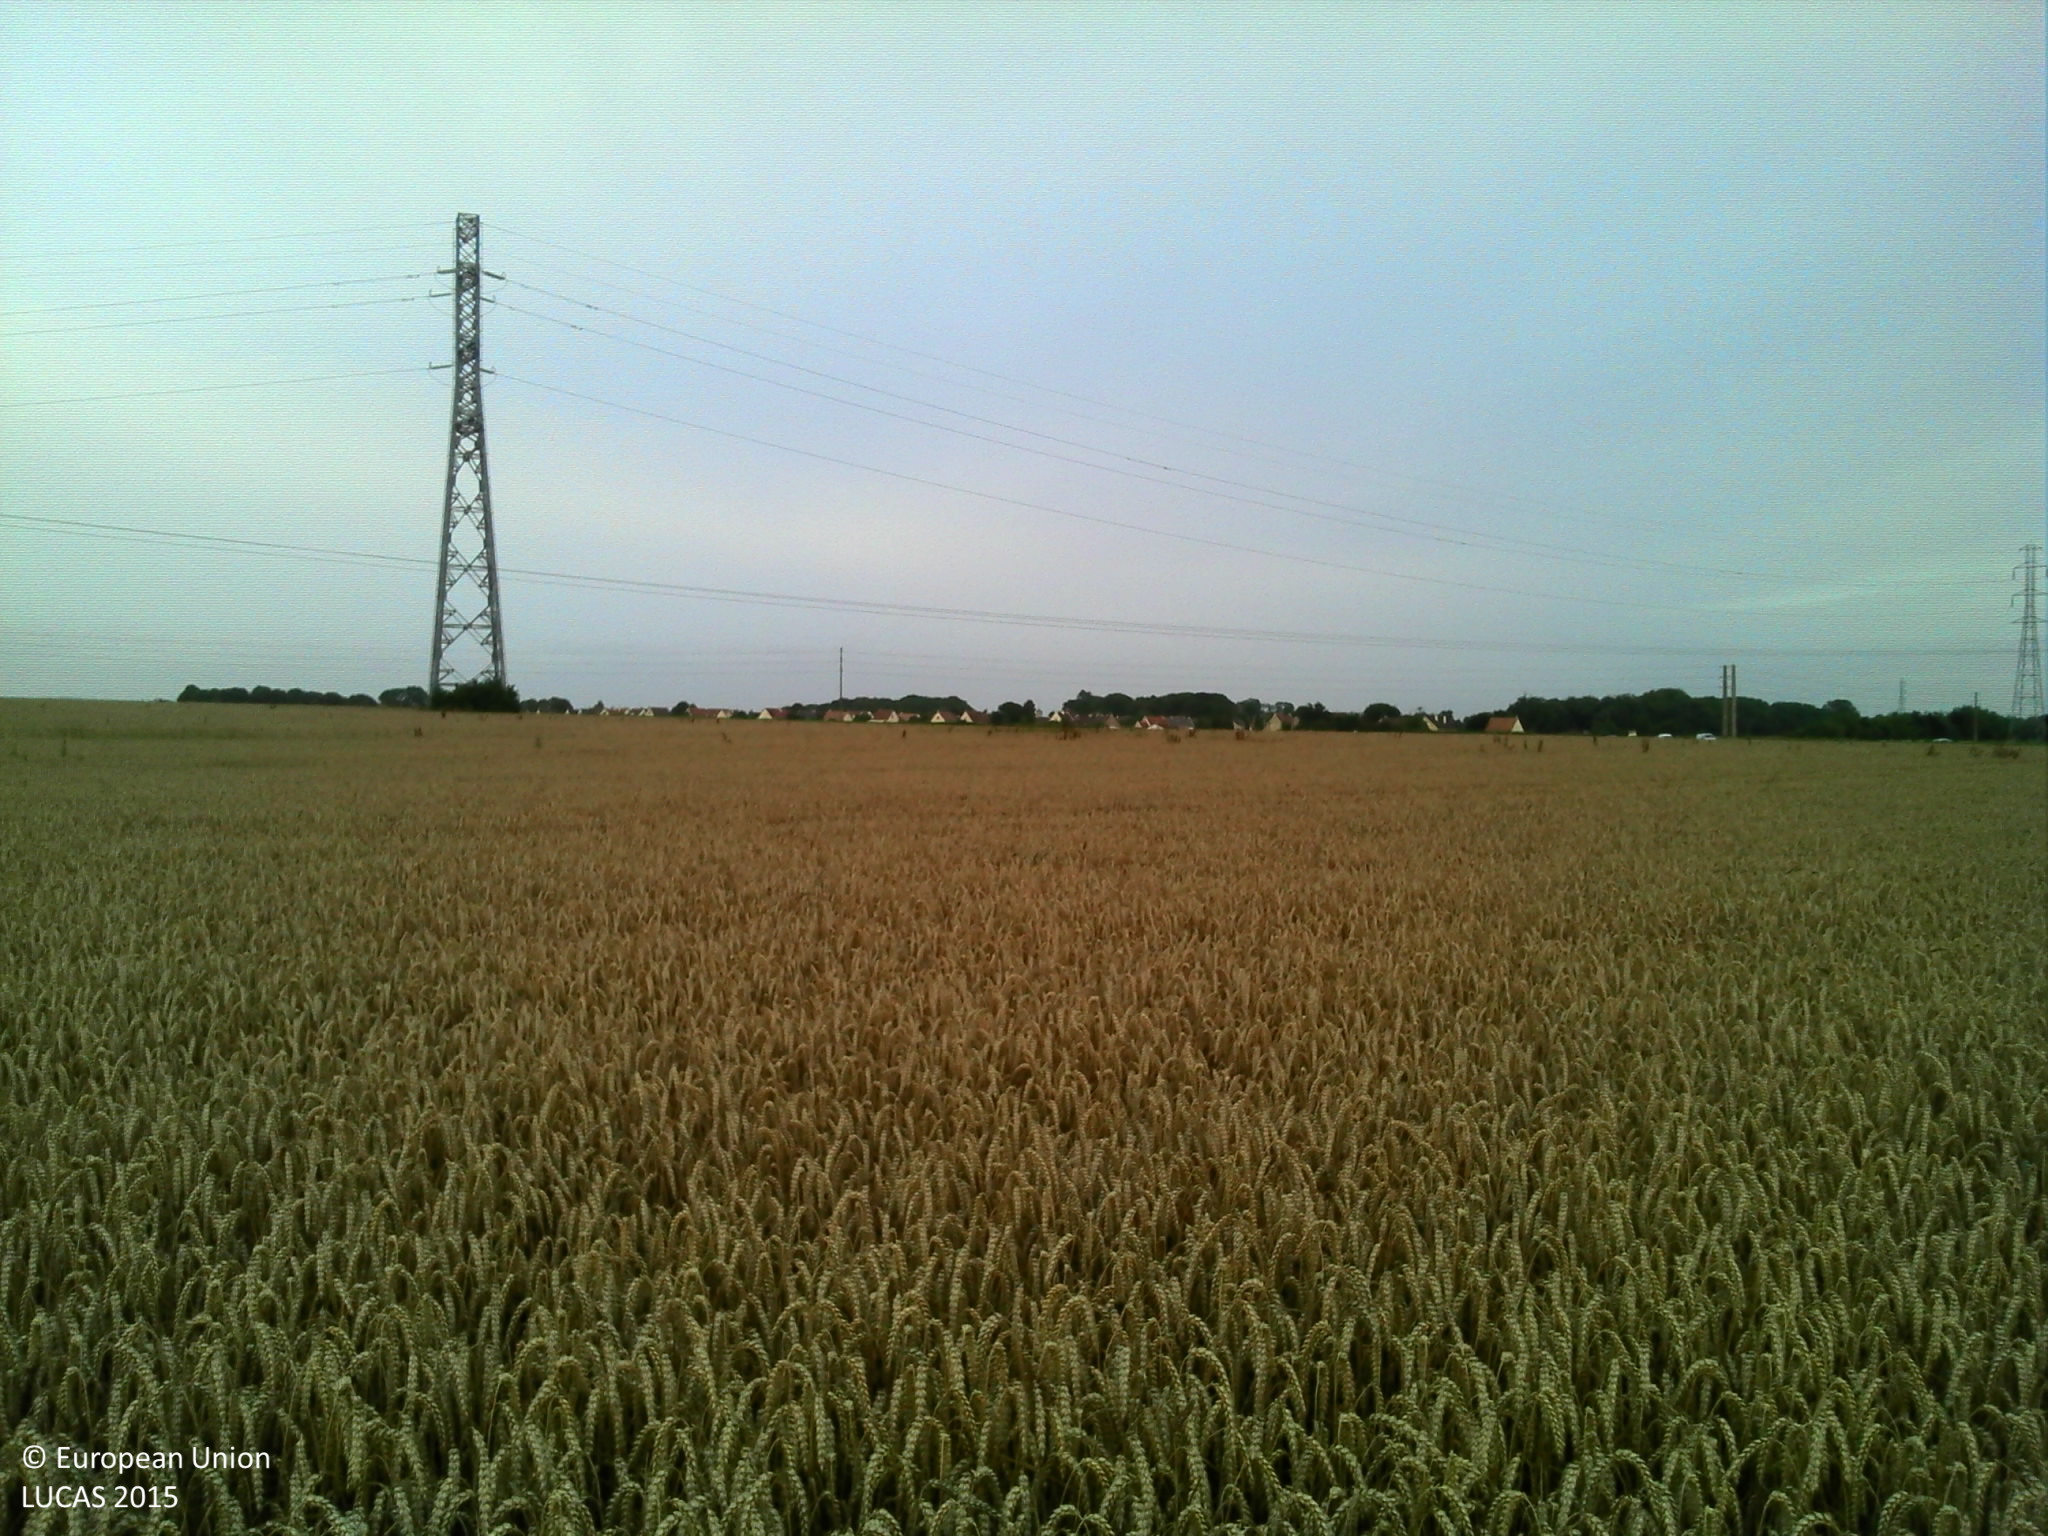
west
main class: Cropland
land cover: Common wheat
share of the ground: > 75 %
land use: Agriculture (excluding fallow land and kitchen gardens)
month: July
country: FR
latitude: 49.2124
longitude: -0.2608
